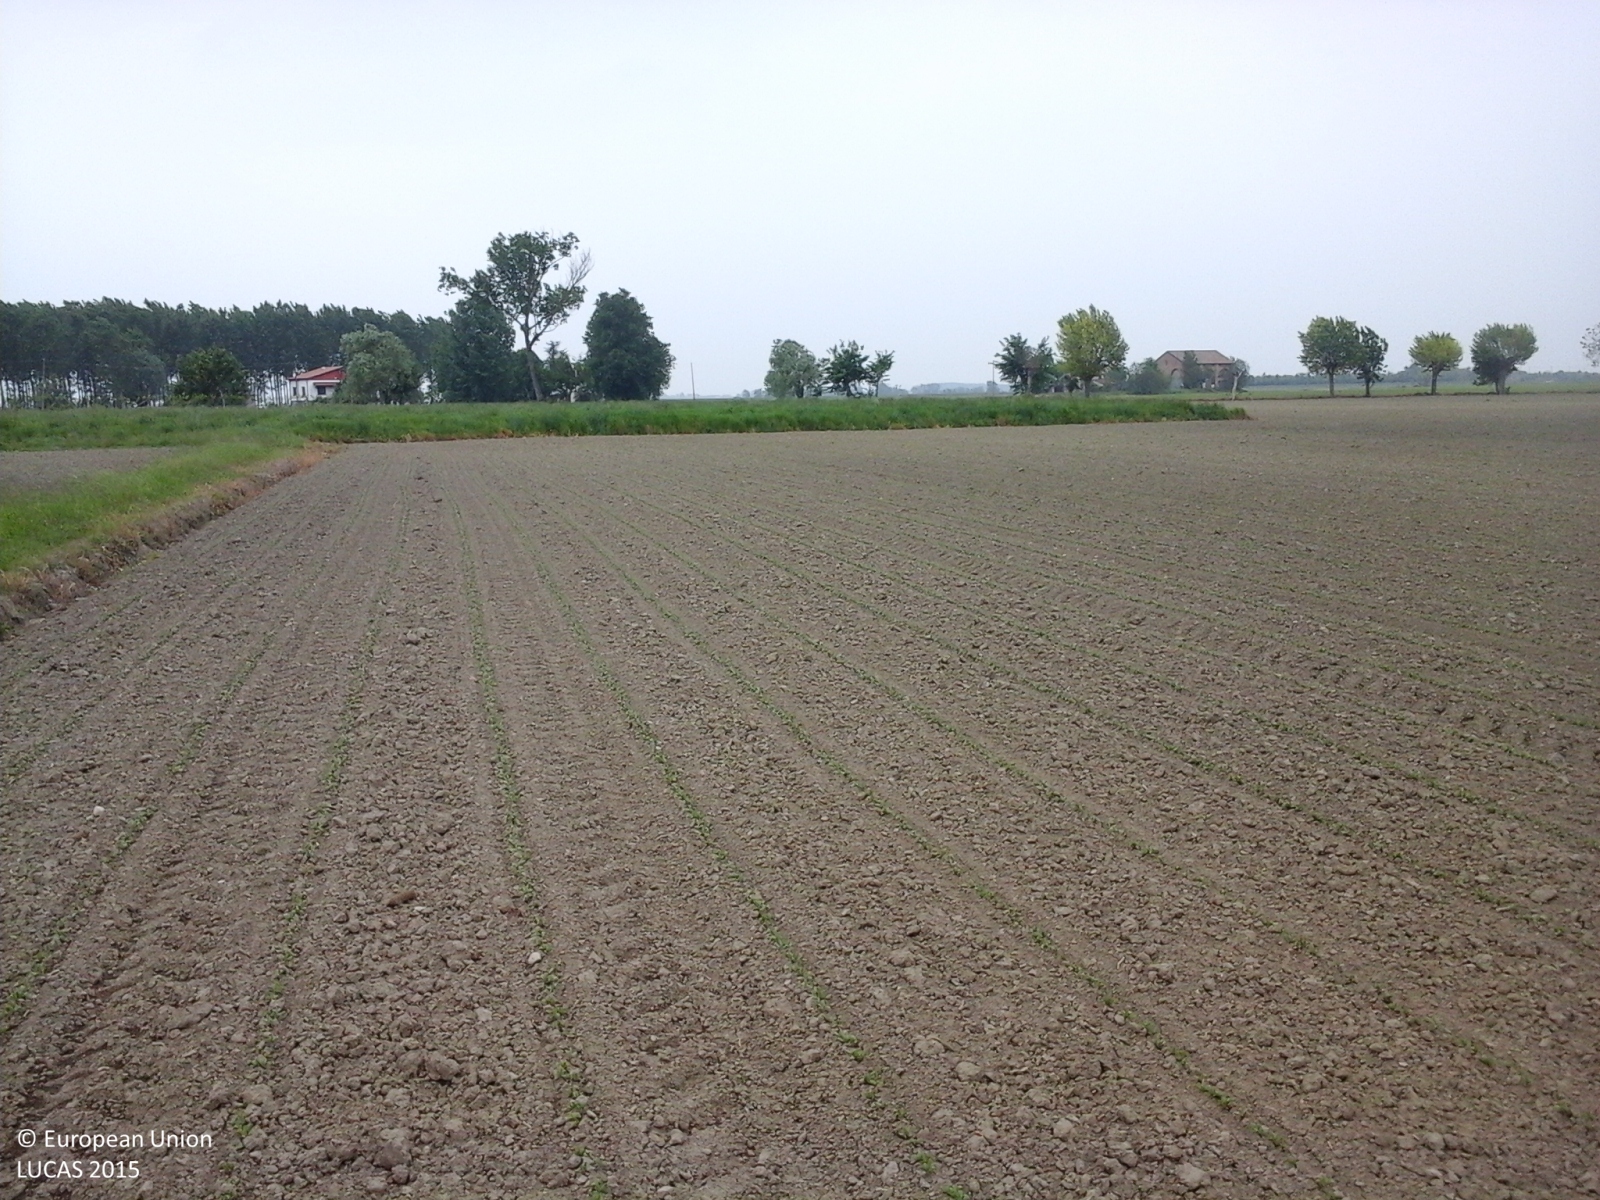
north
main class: Cropland
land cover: Soya
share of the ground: > 75 %
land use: Agriculture (excluding fallow land and kitchen gardens)
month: May
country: IT
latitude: 44.9701
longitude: 11.5566
